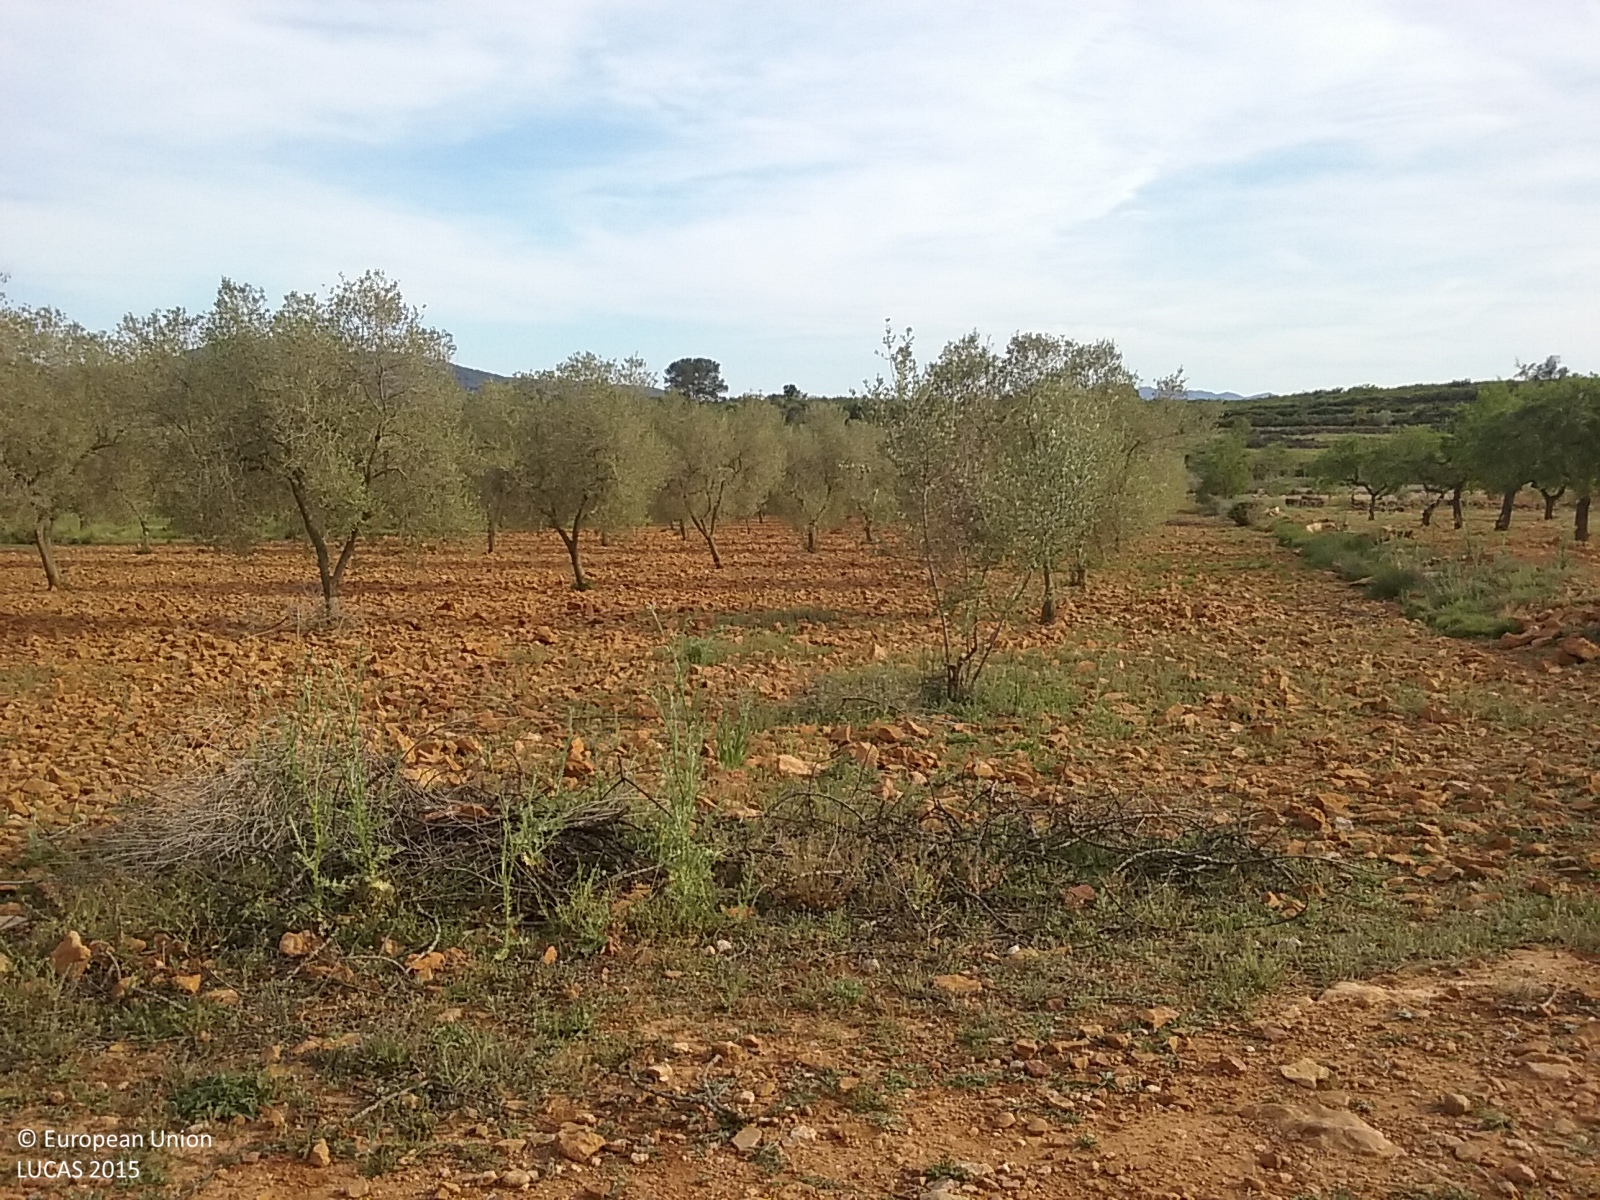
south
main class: Cropland
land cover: Olive groves
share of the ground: 25 - 50 %
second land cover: Grassland without tree/shrub cover
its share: 50 - 75 %
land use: Agriculture (excluding fallow land and kitchen gardens)
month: May
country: ES
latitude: 40.2175
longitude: 0.0680
